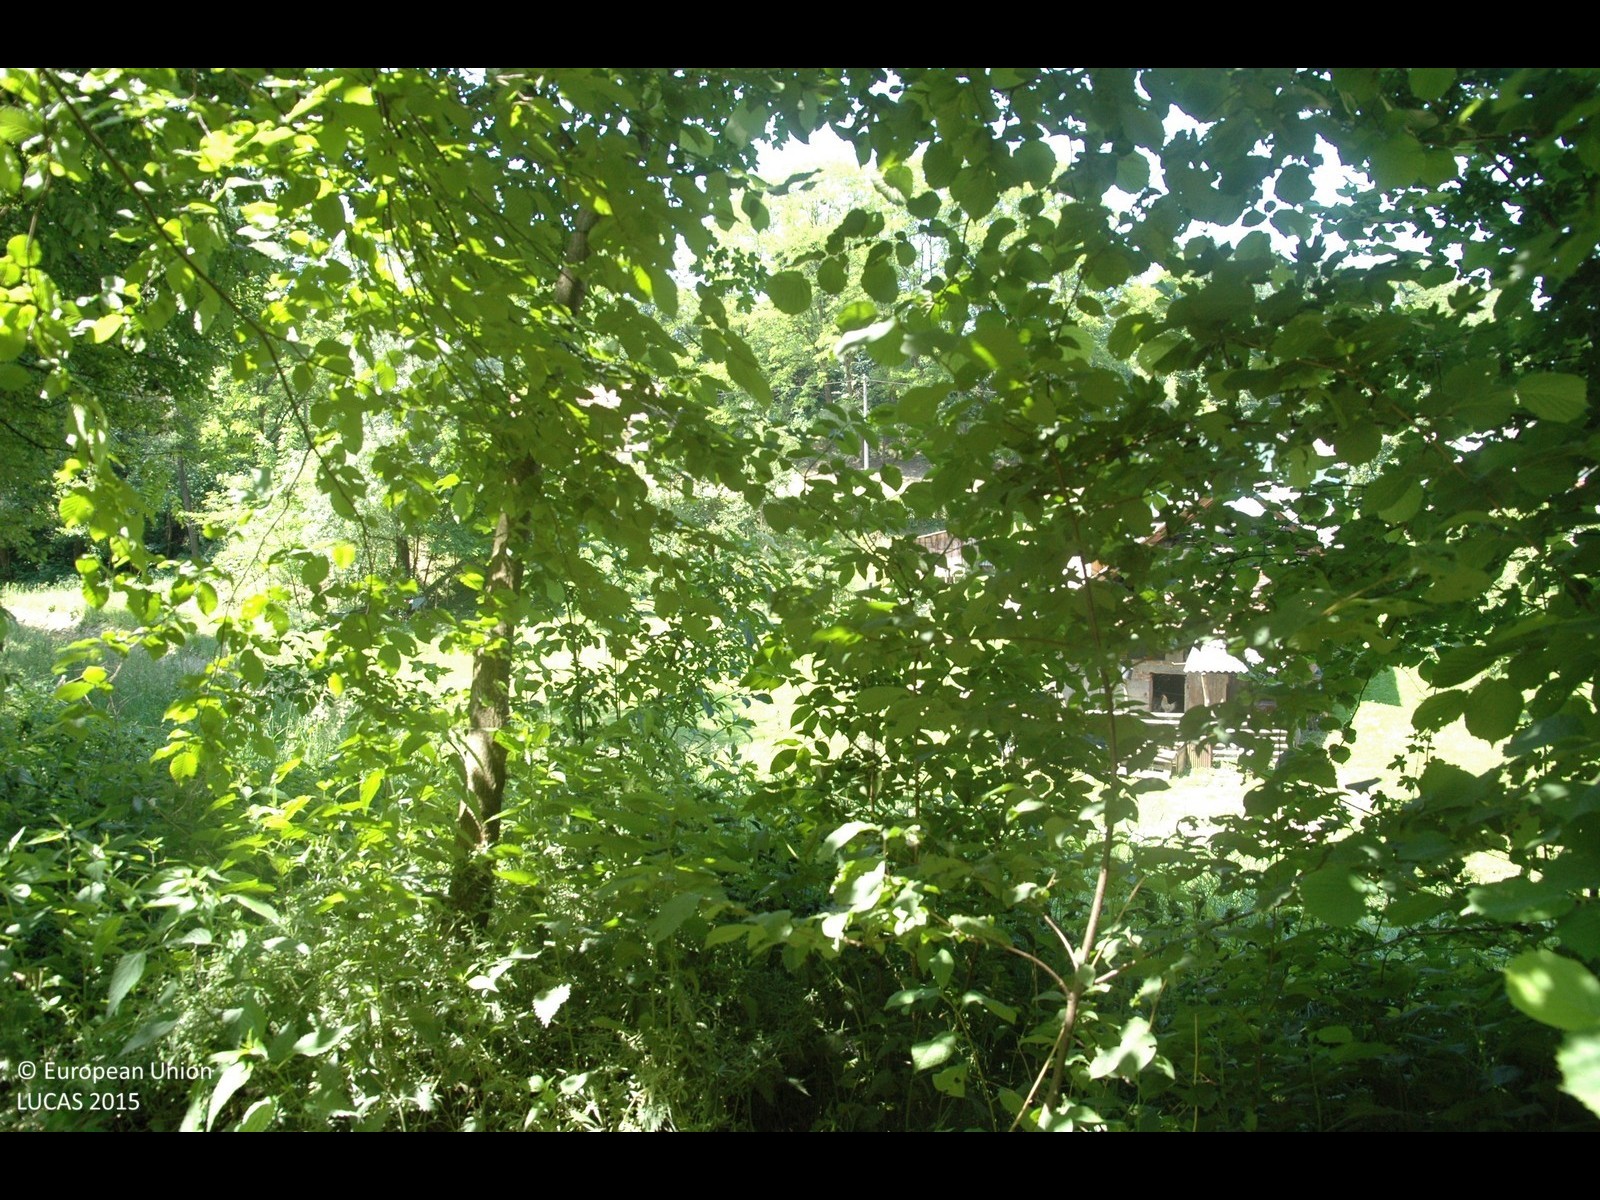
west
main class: Woodland
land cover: Broadleaved woodland
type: beech forest
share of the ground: > 75 %
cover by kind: broadleaved forest trees 90 %, shrubs 5 %, herbaceous plants 5 %
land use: Forestry
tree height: > 5 m
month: May
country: HR
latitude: 46.5238
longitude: 16.3493
